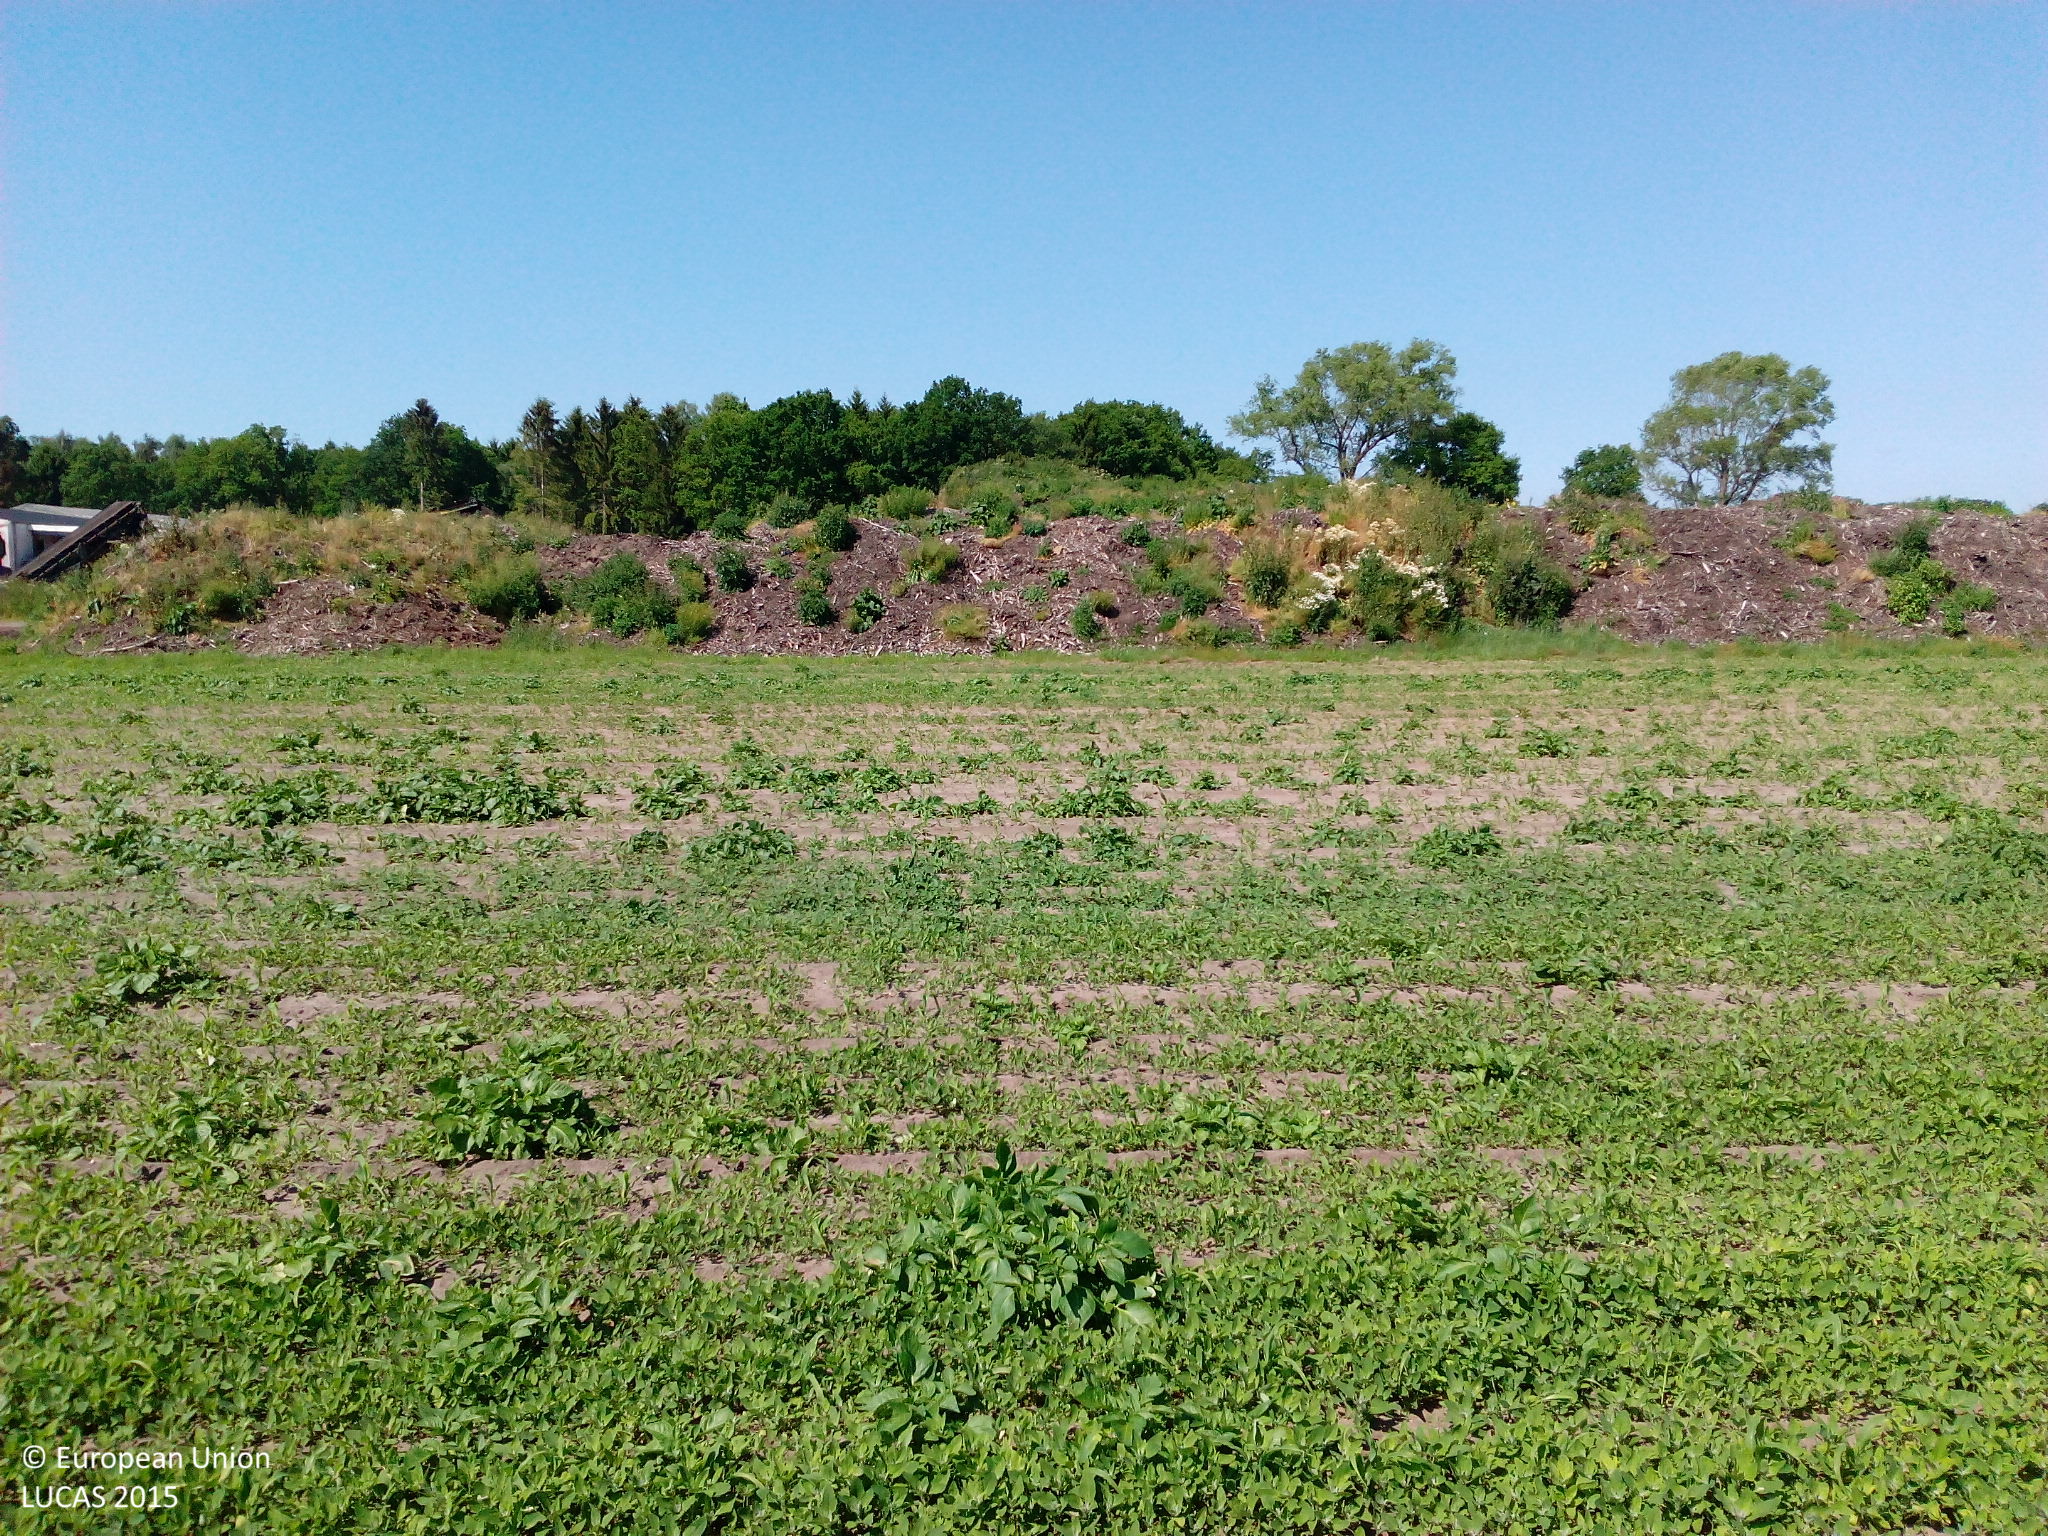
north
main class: Cropland
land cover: Maize
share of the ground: 10 - 25 %
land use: Agriculture (excluding fallow land and kitchen gardens)
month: June
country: DE
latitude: 53.7069
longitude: 9.6518
